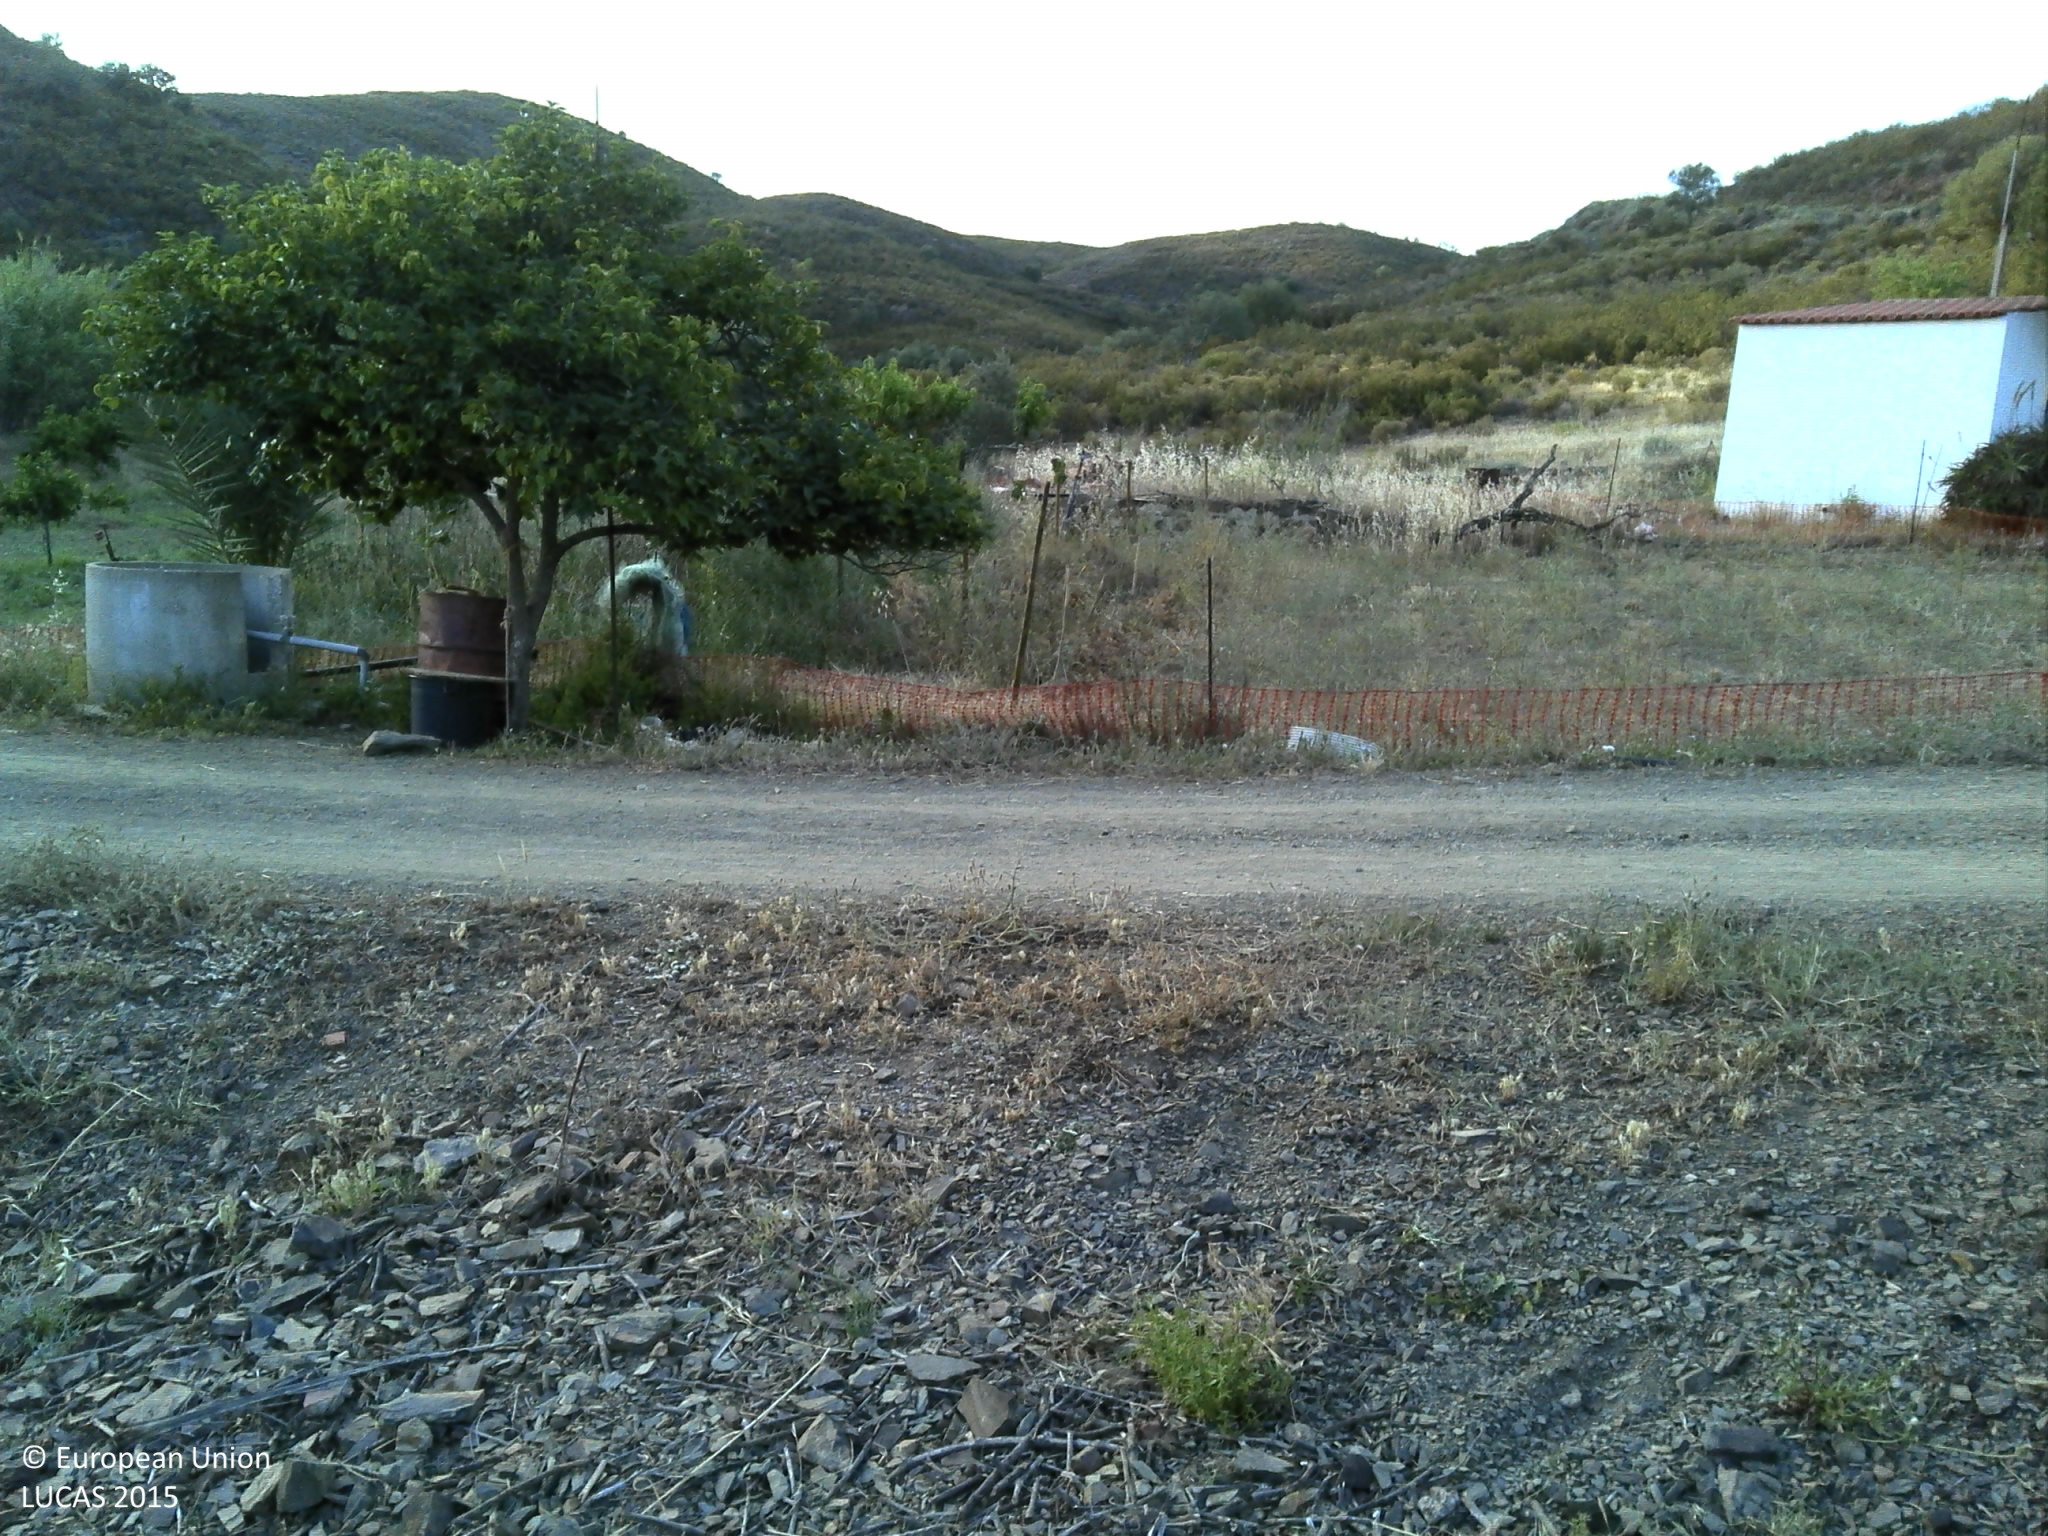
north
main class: Grassland
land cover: Grassland with sparse tree/shrub cover
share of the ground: 25 - 50 %
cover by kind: herbaceous plants 45 %, unconsolidated bare surface 40 %, broadleaved forest trees 5 %
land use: Abandoned areas
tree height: < 5 m
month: May
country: PT
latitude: 37.2769
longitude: -7.4969
